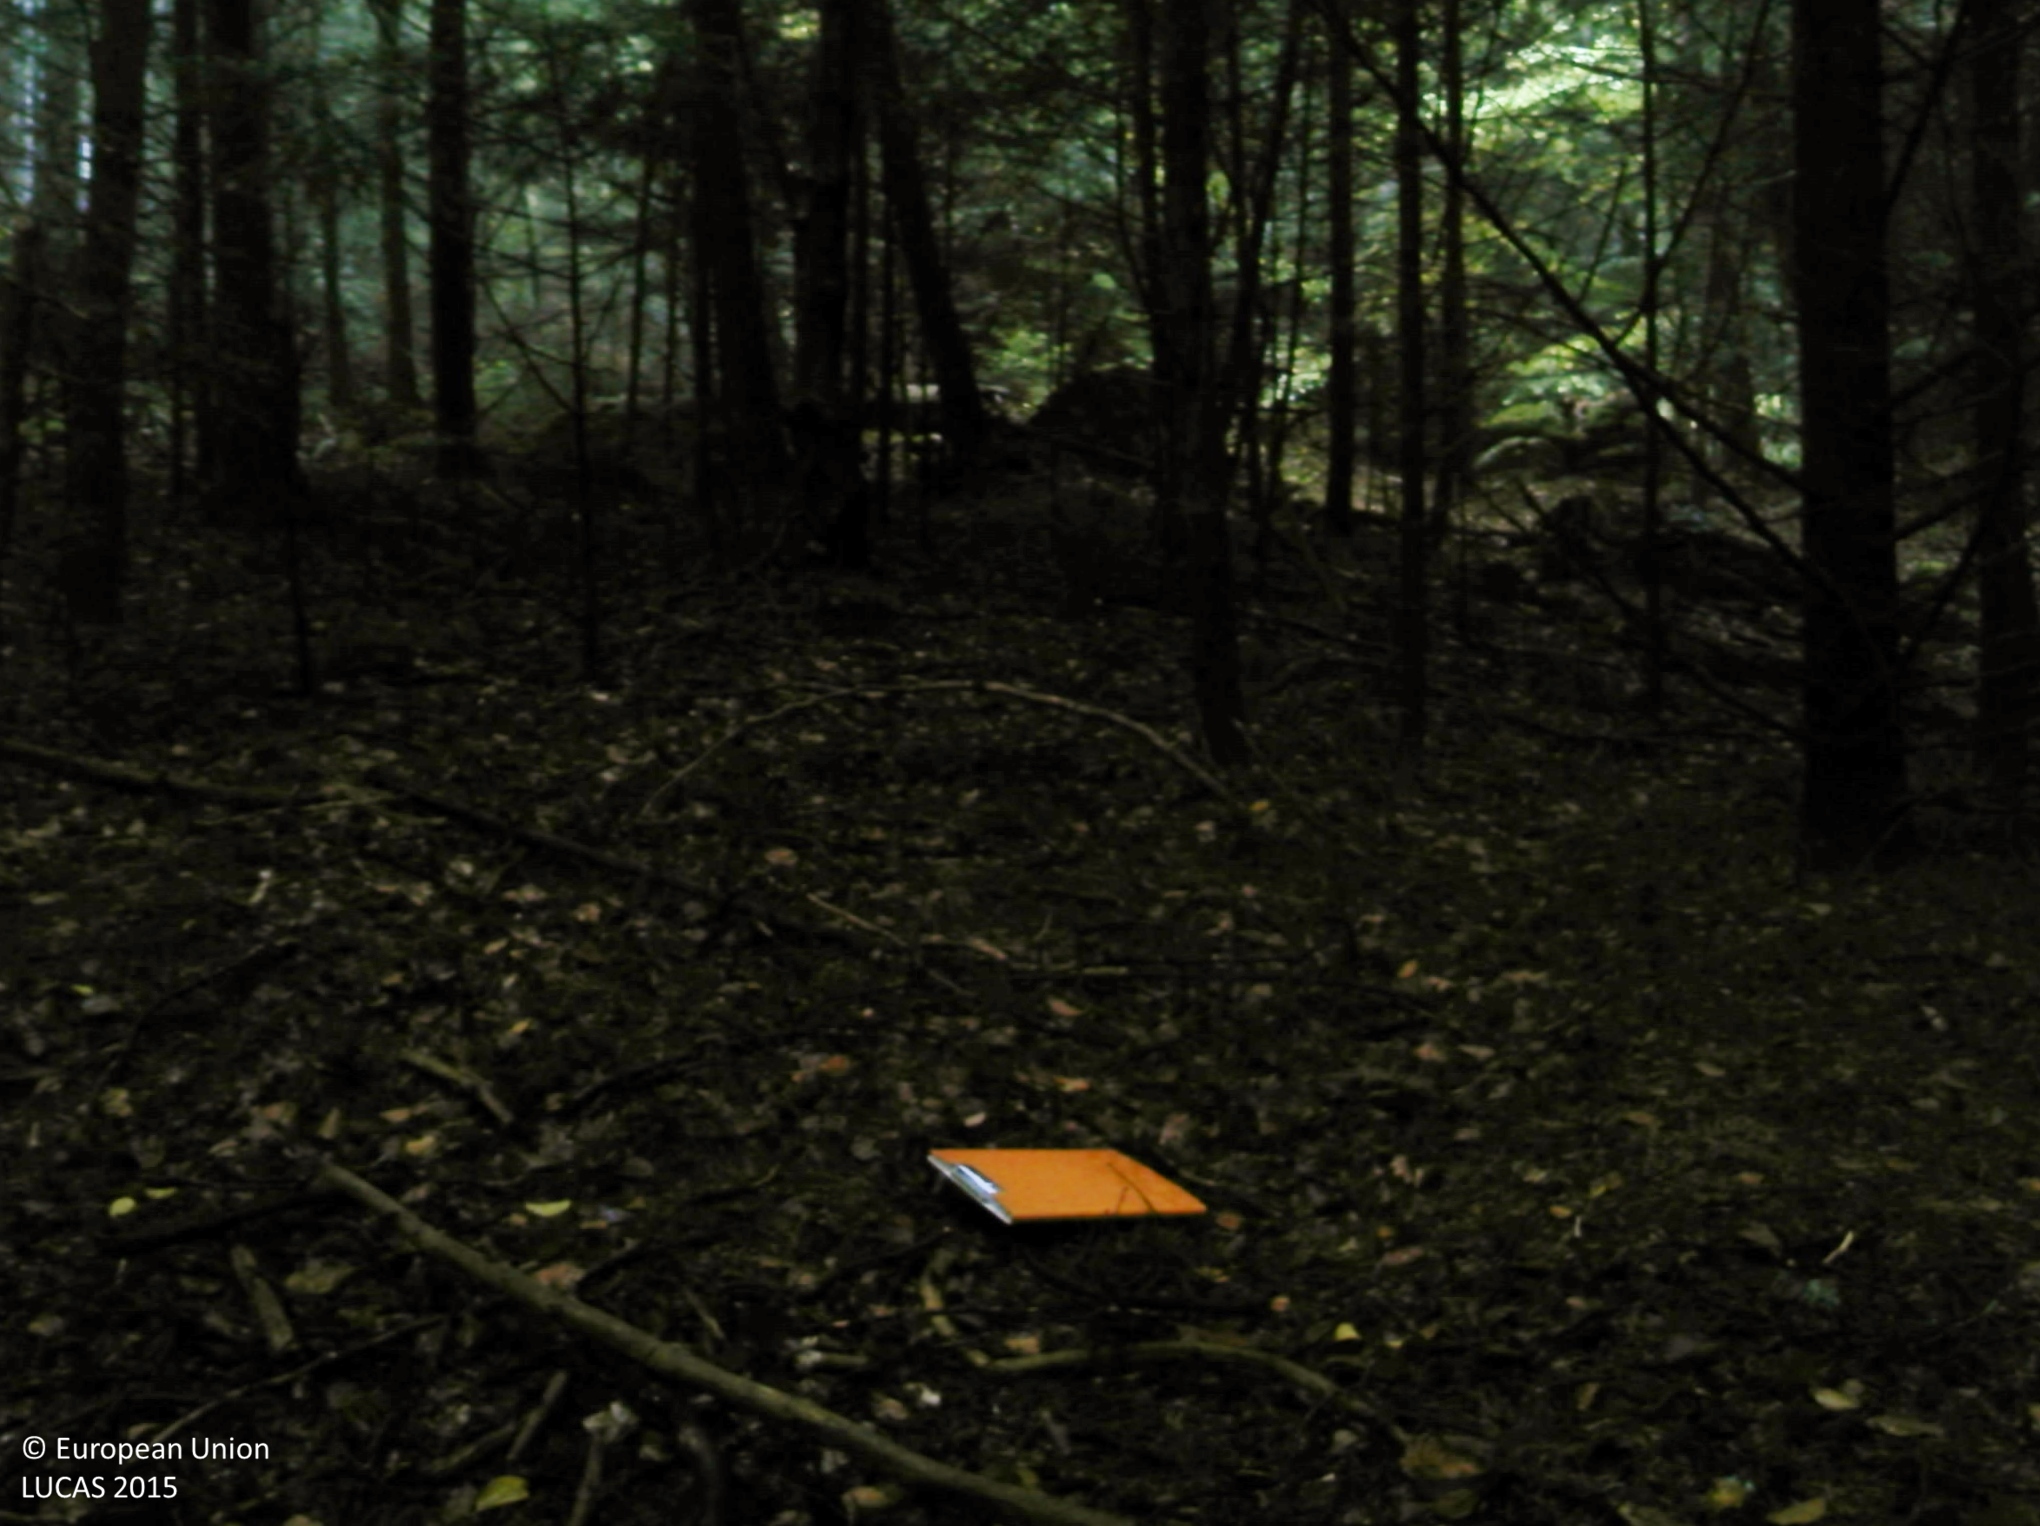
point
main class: Woodland
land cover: Pine dominated mixed woodland
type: mountainous beech forest
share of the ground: > 75 %
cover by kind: coniferous forest trees 50 %, broadleaved forest trees 40 %, unconsolidated bare surface 10 %
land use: Forestry
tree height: > 5 m
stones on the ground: 10 - 25 %
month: October
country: FR
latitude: 45.3754
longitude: 3.7841
